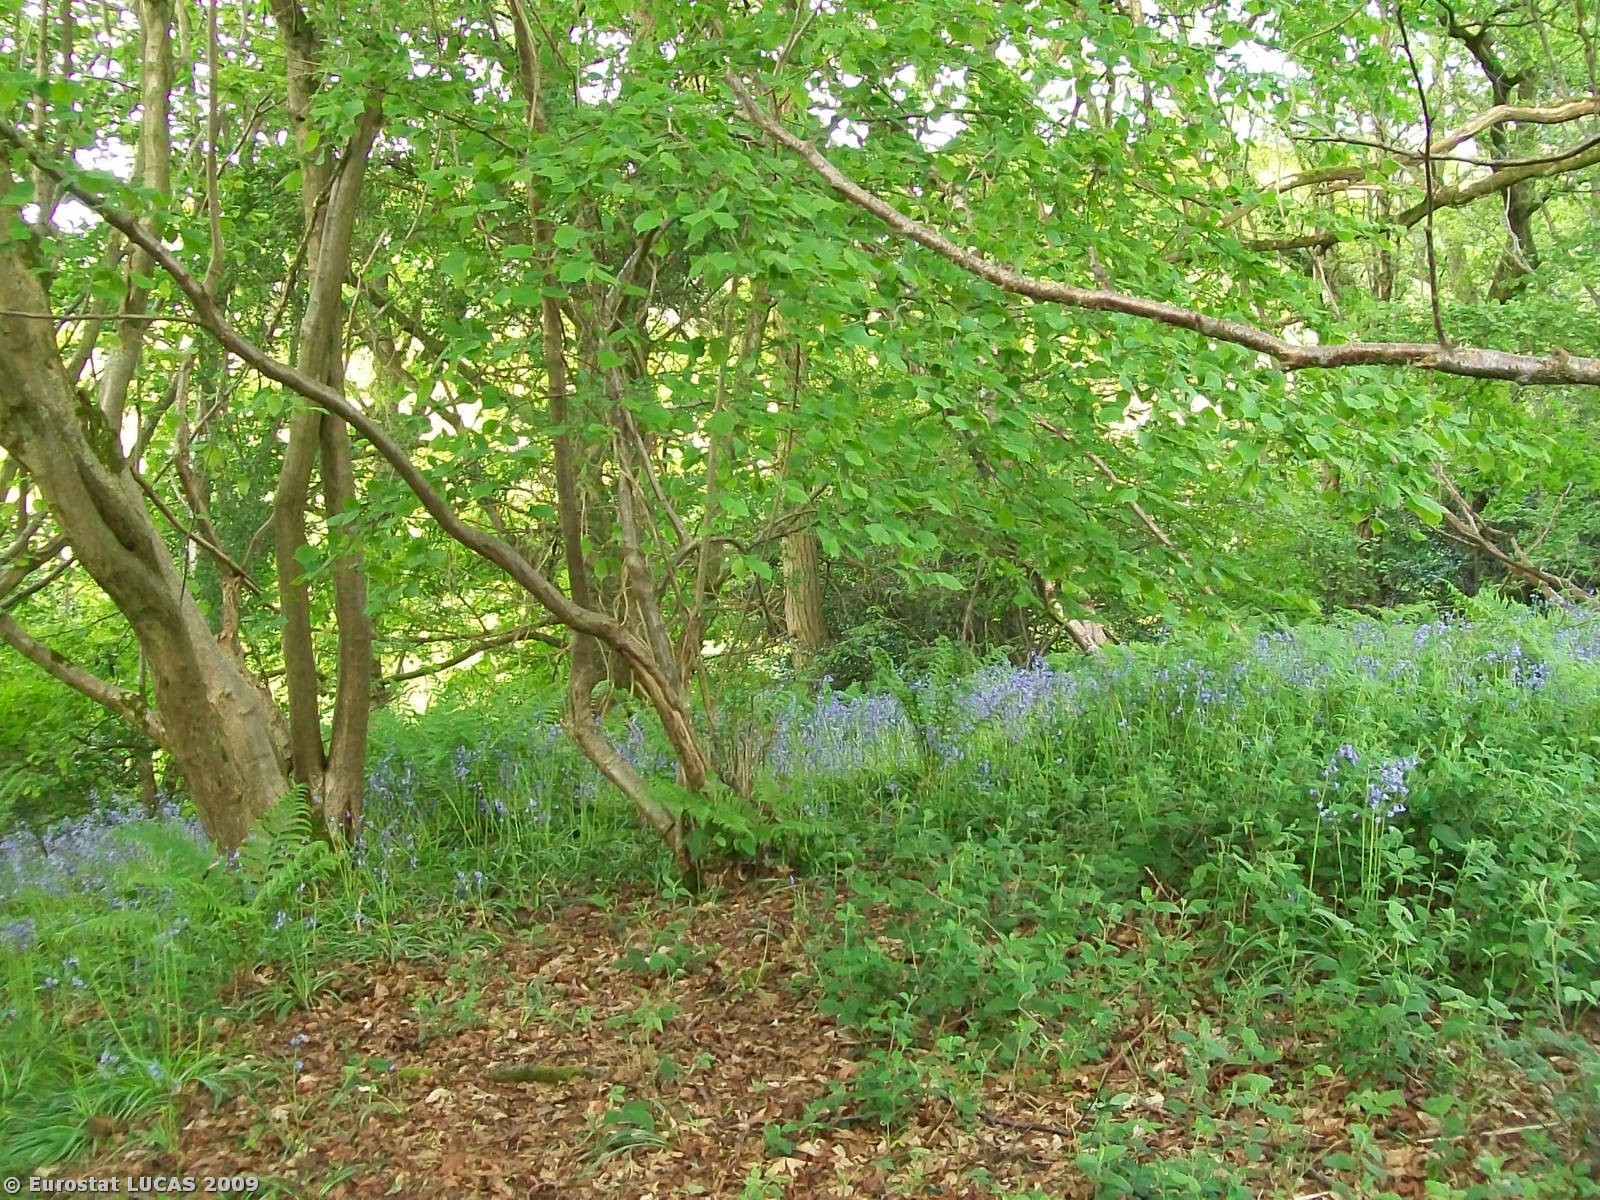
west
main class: Woodland
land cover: Broadleaved woodland
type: mesophytic deciduous forest
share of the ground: > 75 %
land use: Unused
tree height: > 5 m
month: May
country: GB
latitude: 51.0245
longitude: -2.1363
